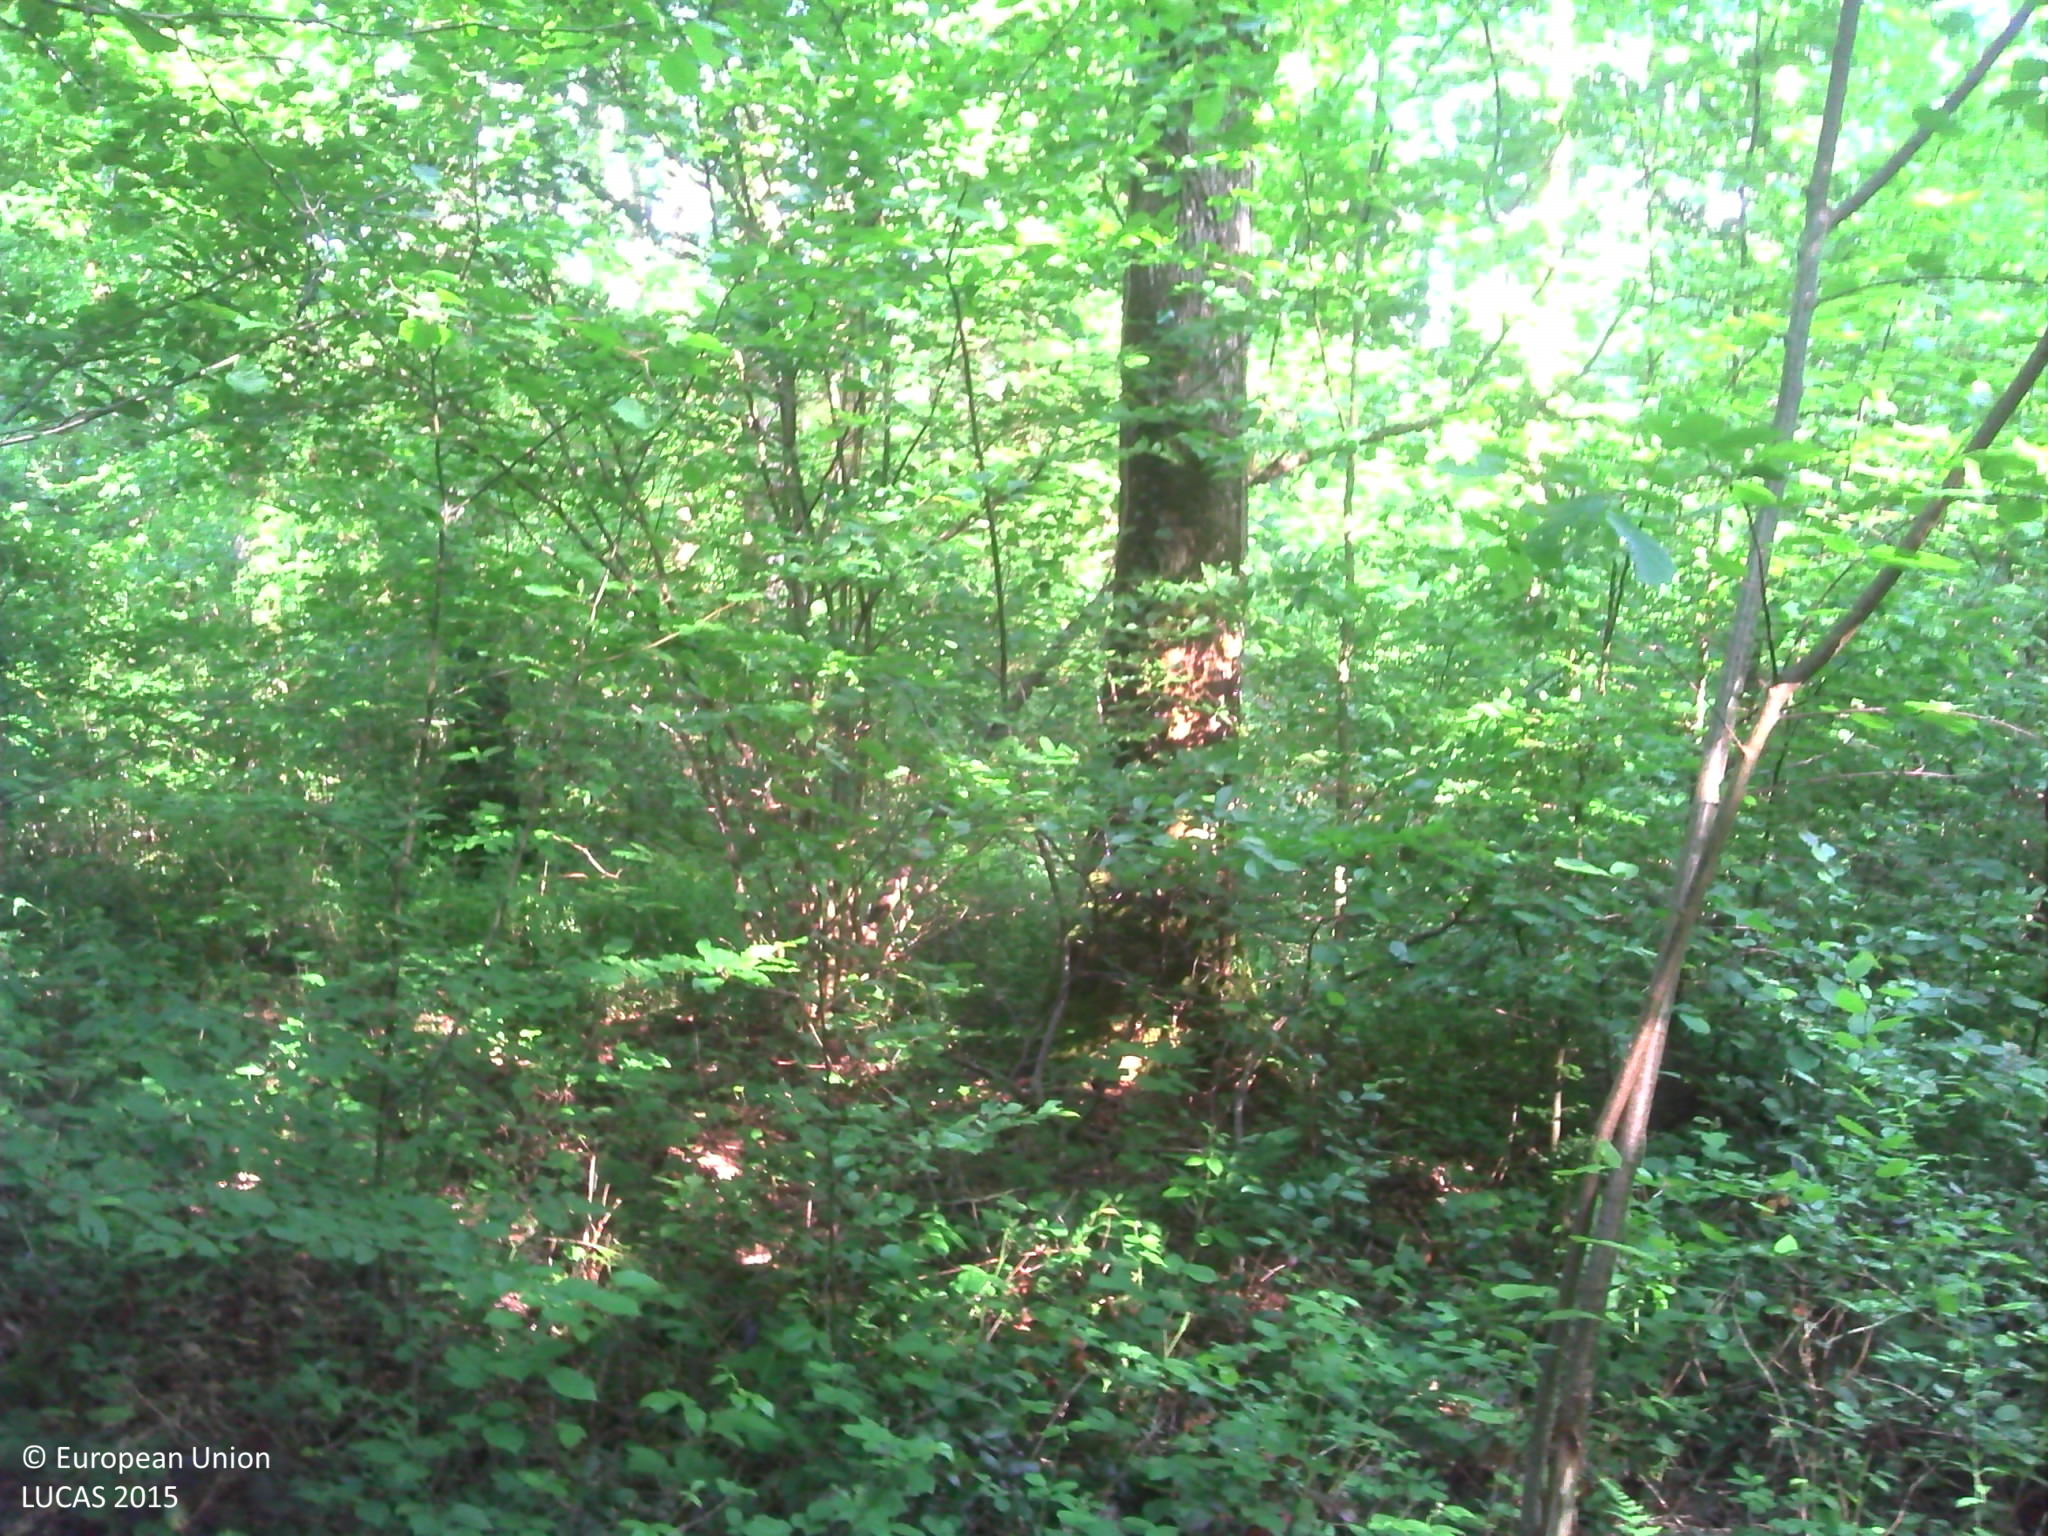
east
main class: Woodland
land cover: Broadleaved woodland
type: mesophytic deciduous forest
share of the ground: > 75 %
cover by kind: broadleaved forest trees 90 %, herbaceous plants 10 %
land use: Forestry
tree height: > 5 m
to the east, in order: Broadleaved woodland; Tracks; Broadleaved woodland
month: June
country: FR
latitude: 48.5546
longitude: 4.8633
